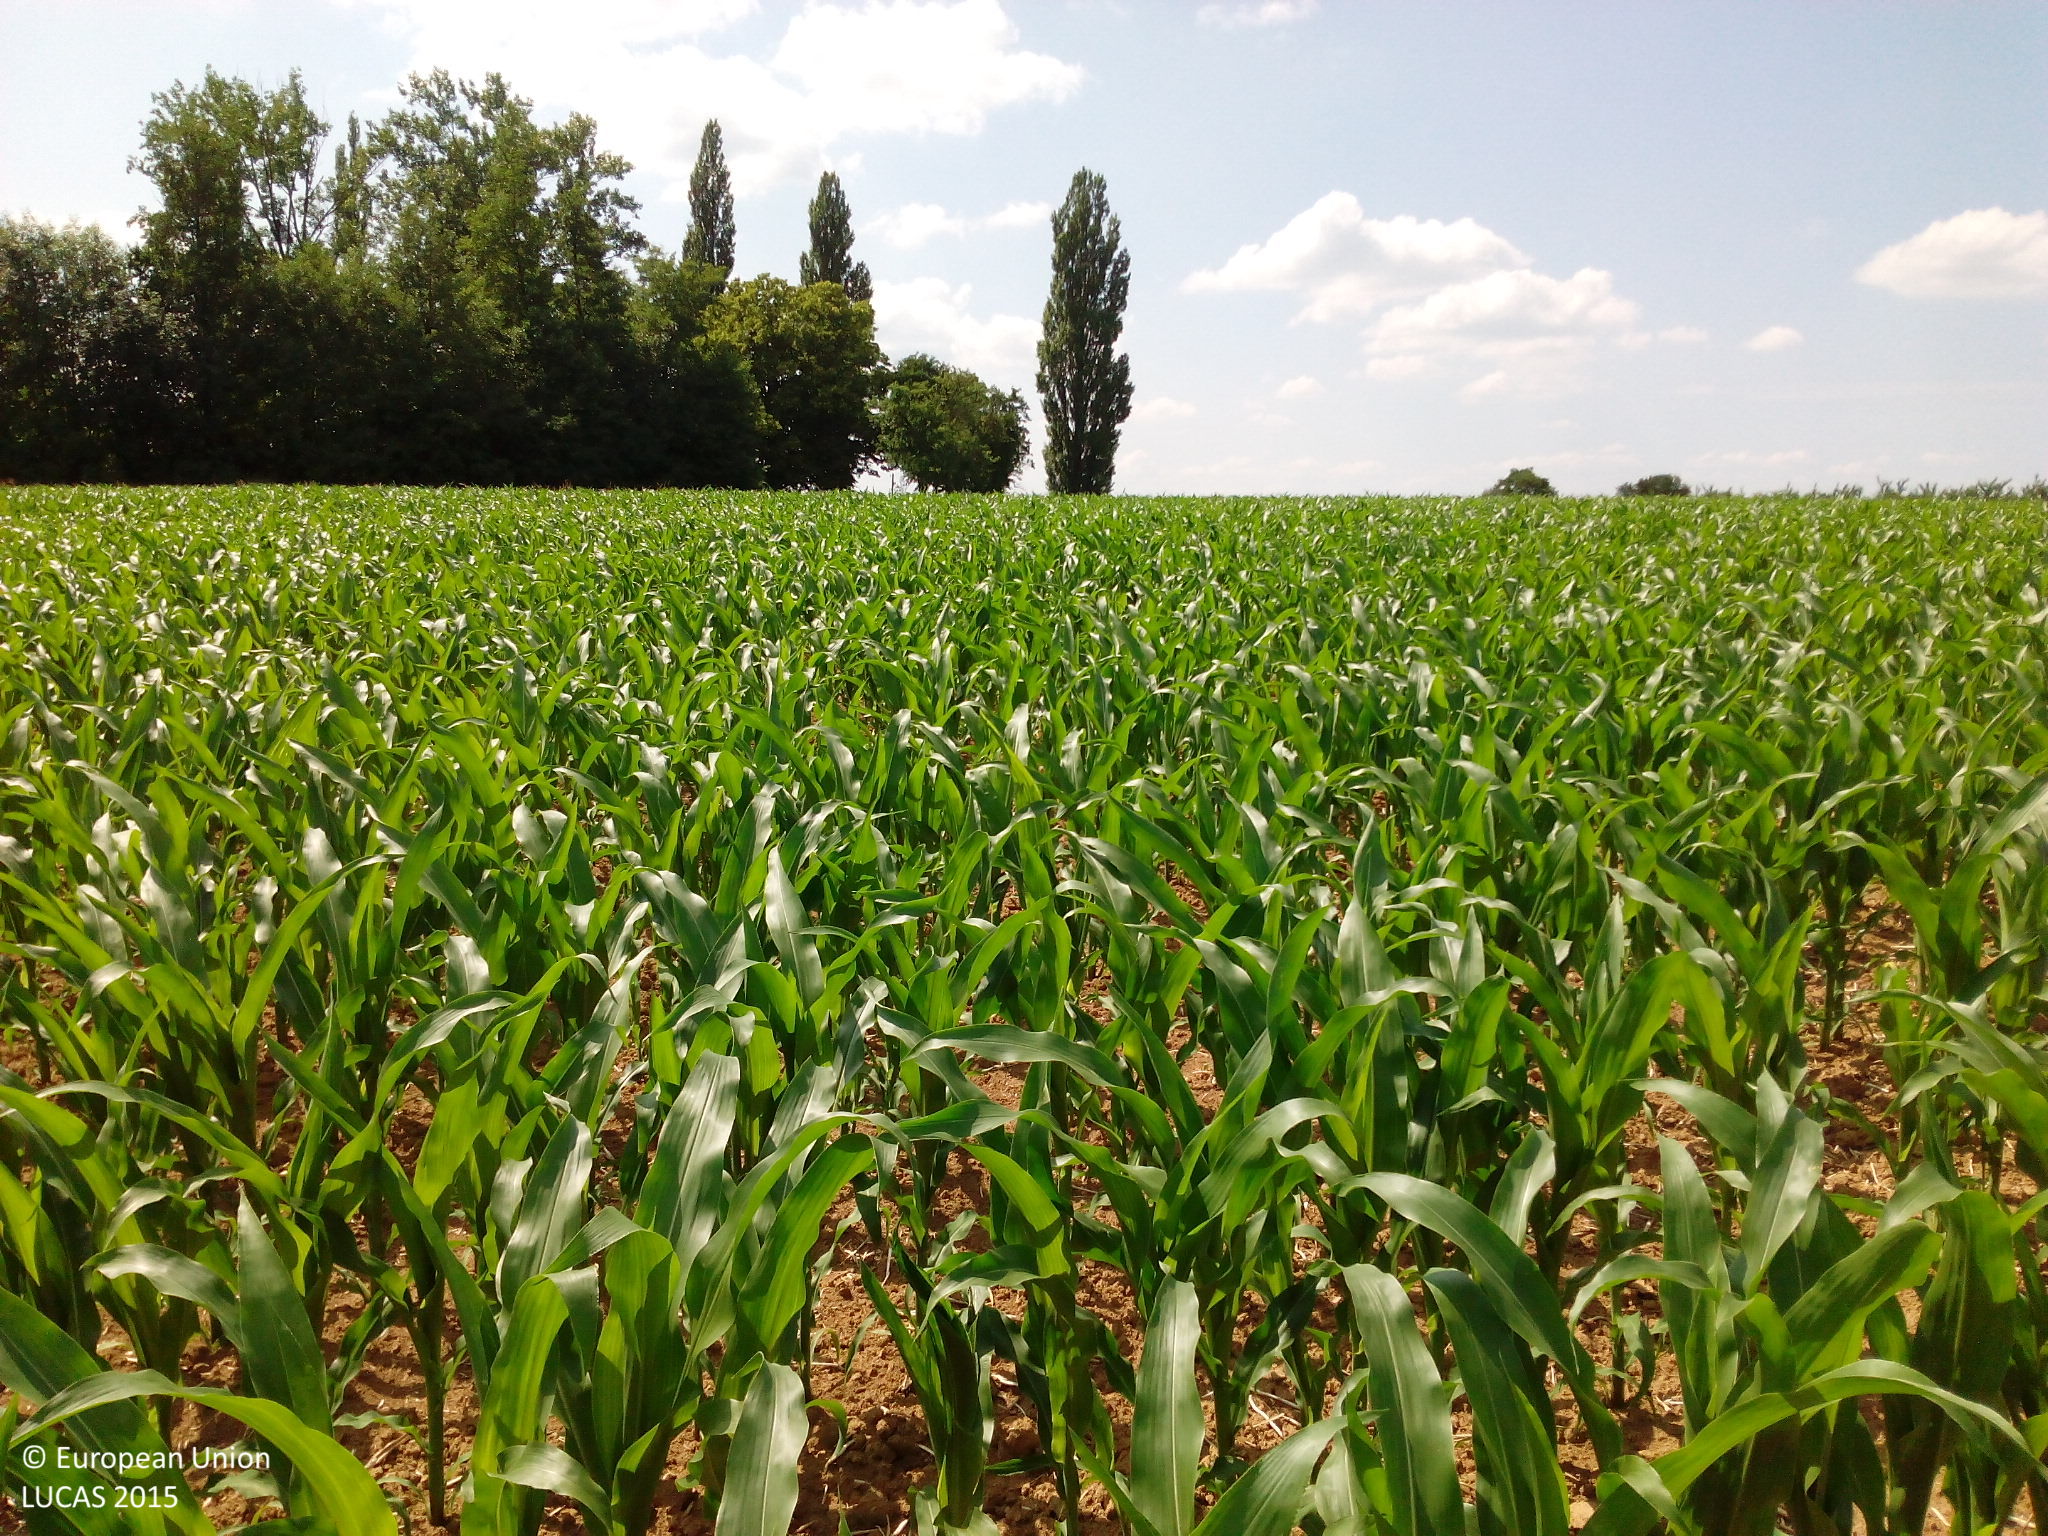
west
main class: Cropland
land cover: Maize
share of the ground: > 75 %
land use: Agriculture (excluding fallow land and kitchen gardens)
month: June
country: DE
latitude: 49.2662
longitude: 9.5742
